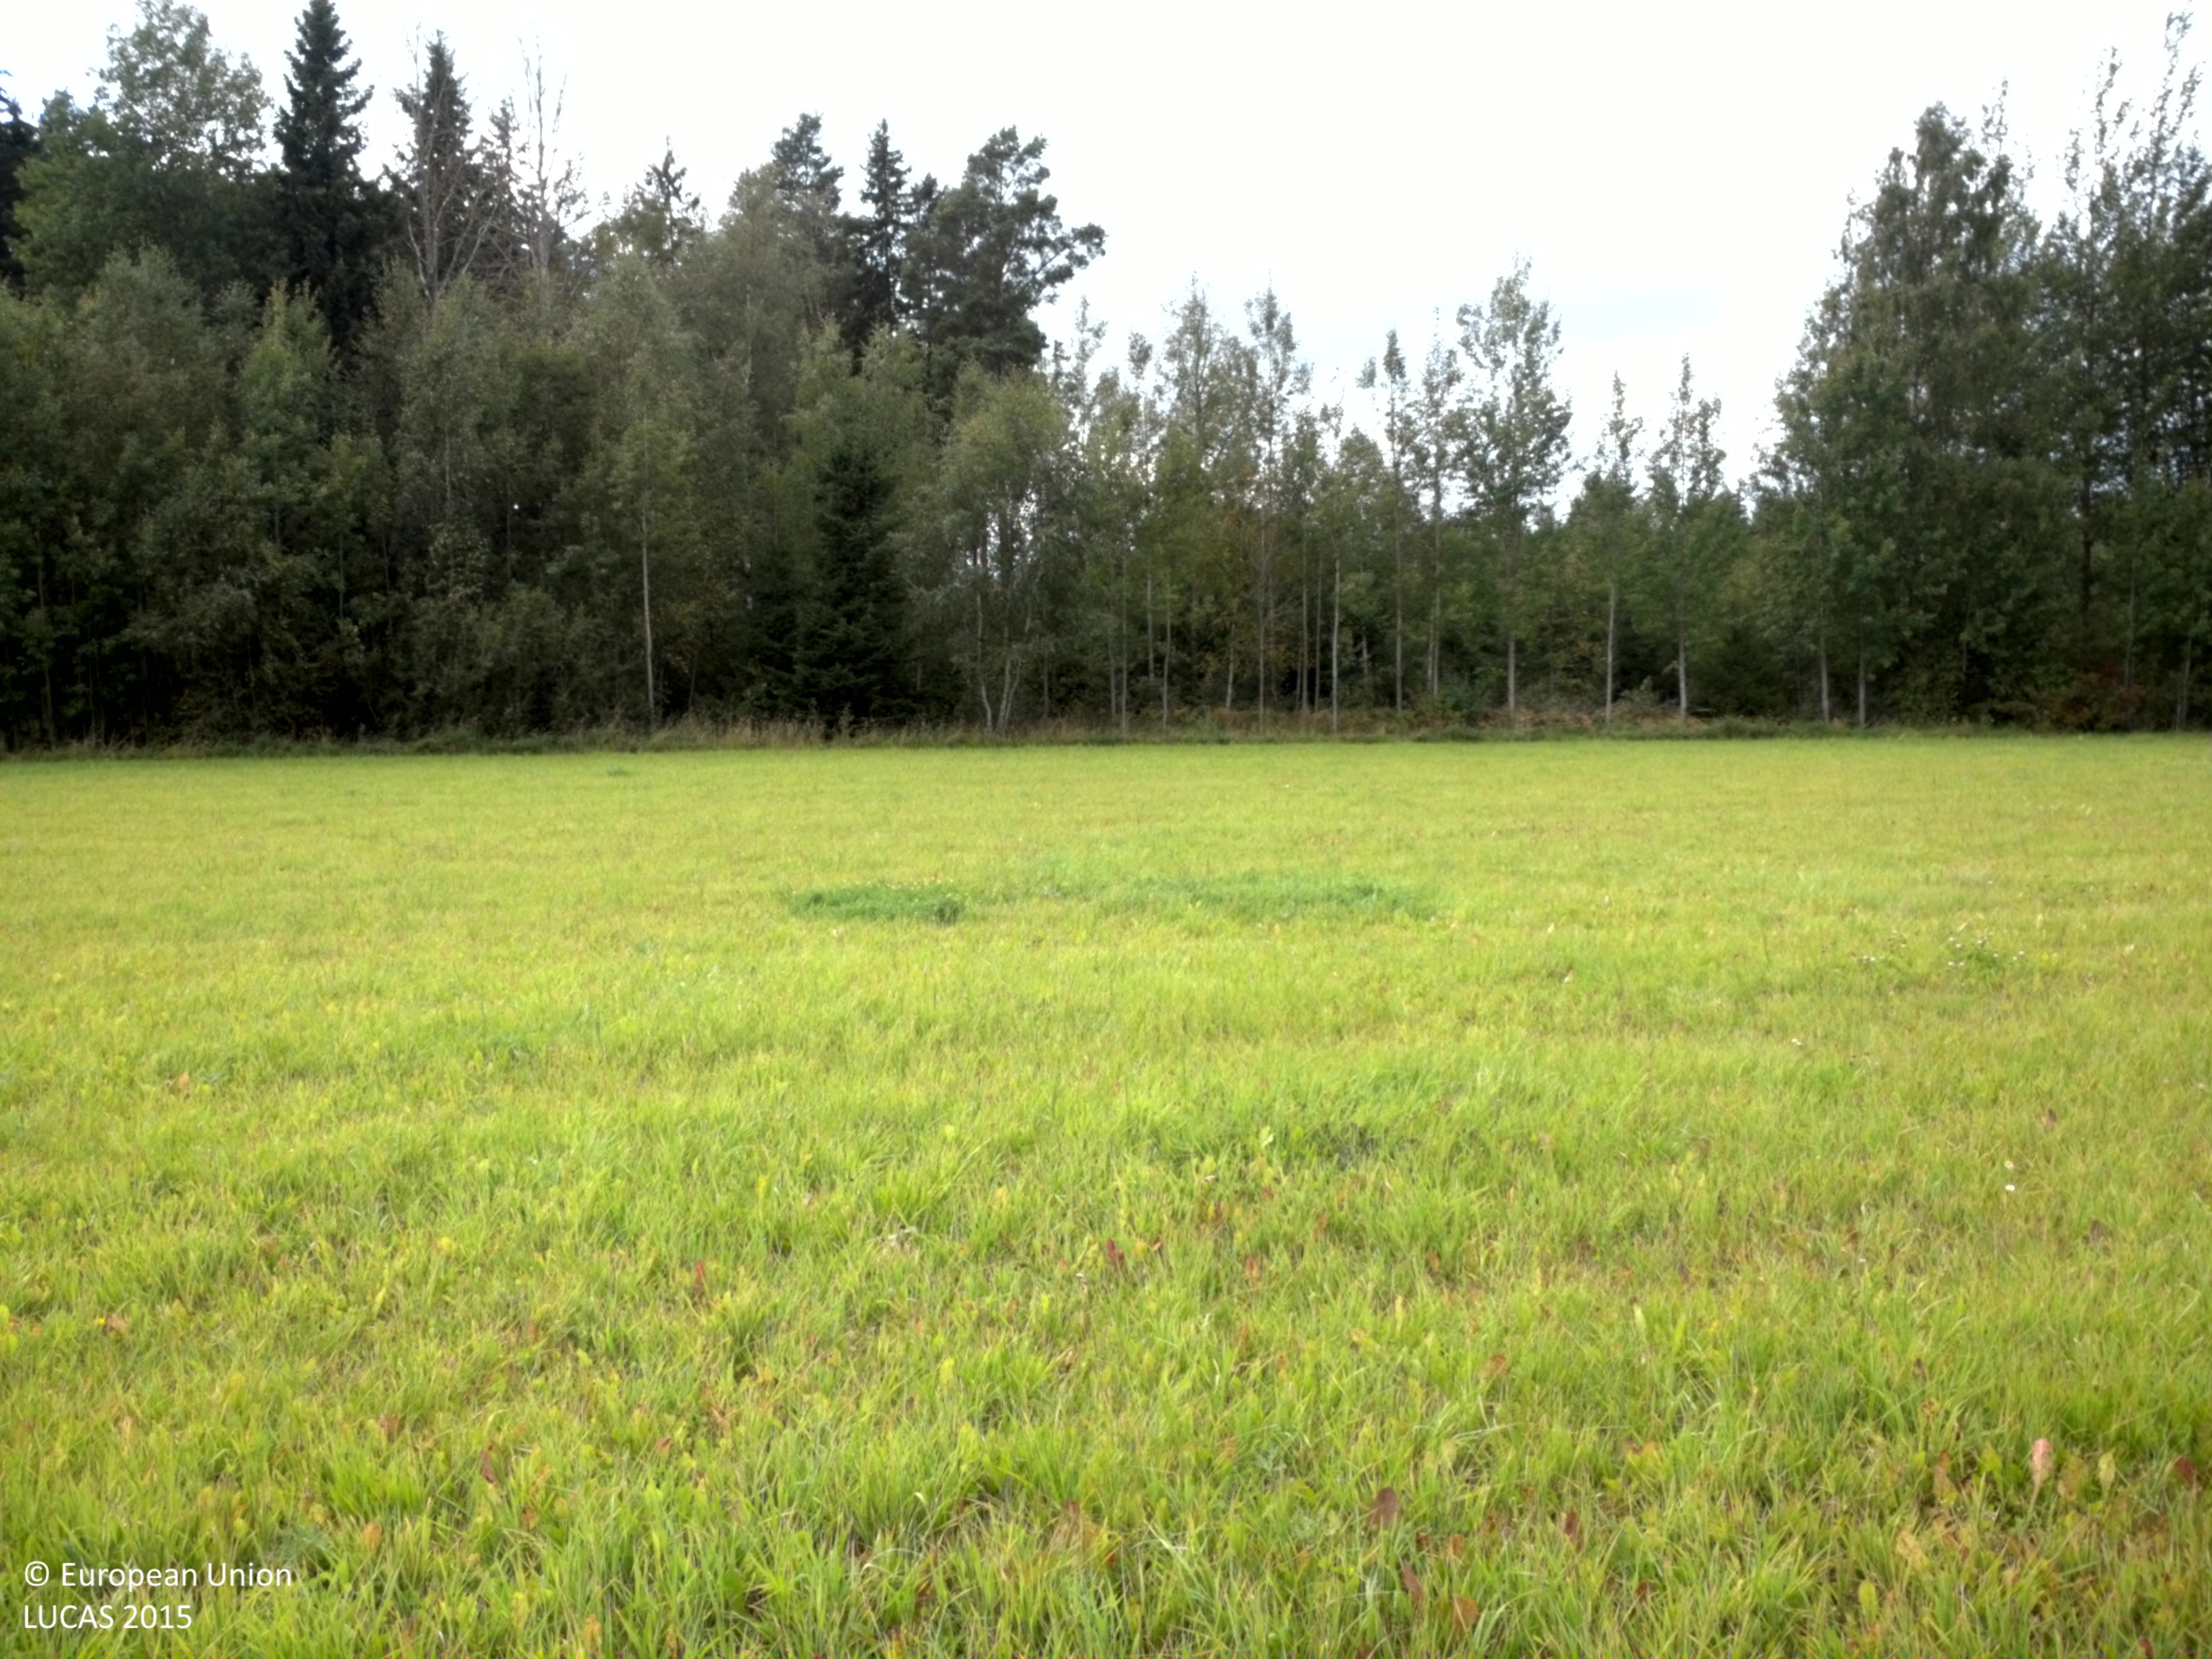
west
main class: Grassland
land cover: Grassland without tree/shrub cover
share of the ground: > 75 %
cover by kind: herbaceous plants 100 %
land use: Agriculture (excluding fallow land and kitchen gardens)
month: August
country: SE
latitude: 59.6596
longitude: 17.0748
